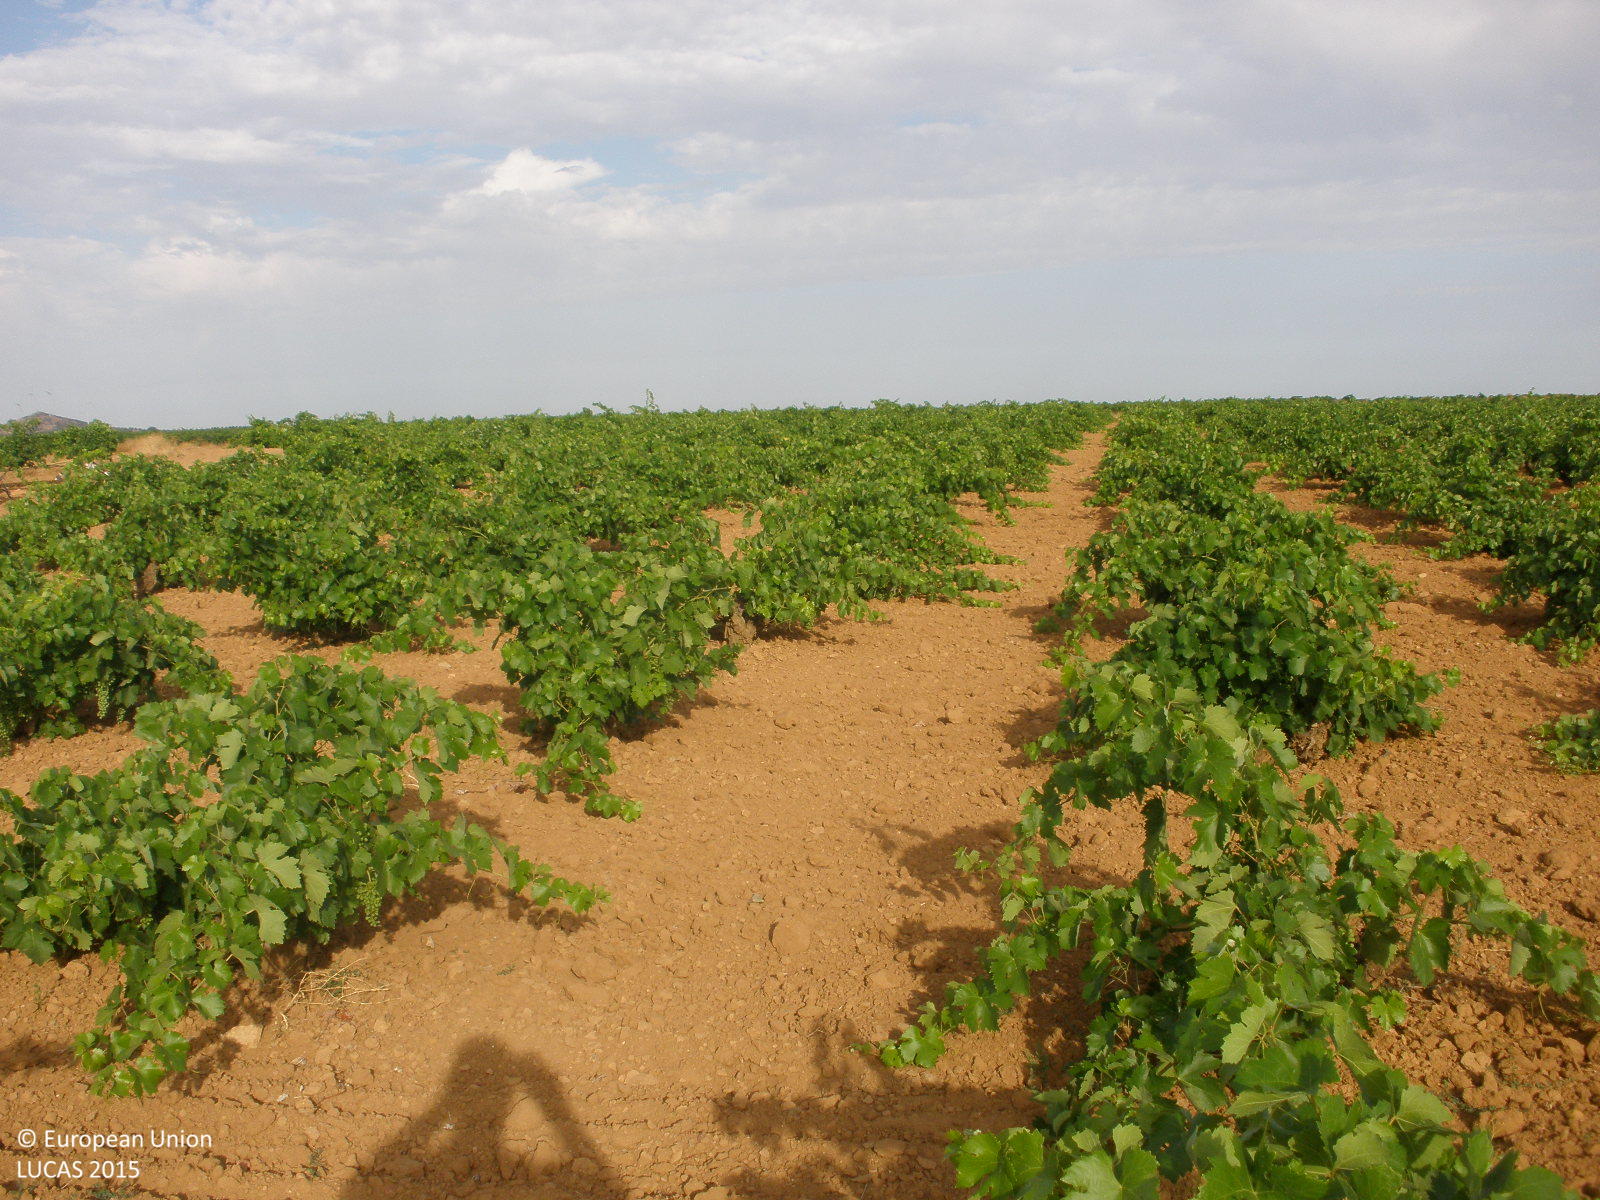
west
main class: Cropland
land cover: Vineyards
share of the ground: 50 - 75 %
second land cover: Other bare soil
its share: > 75 %
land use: Agriculture (excluding fallow land and kitchen gardens)
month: July
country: ES
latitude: 39.7703
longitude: -3.2267
